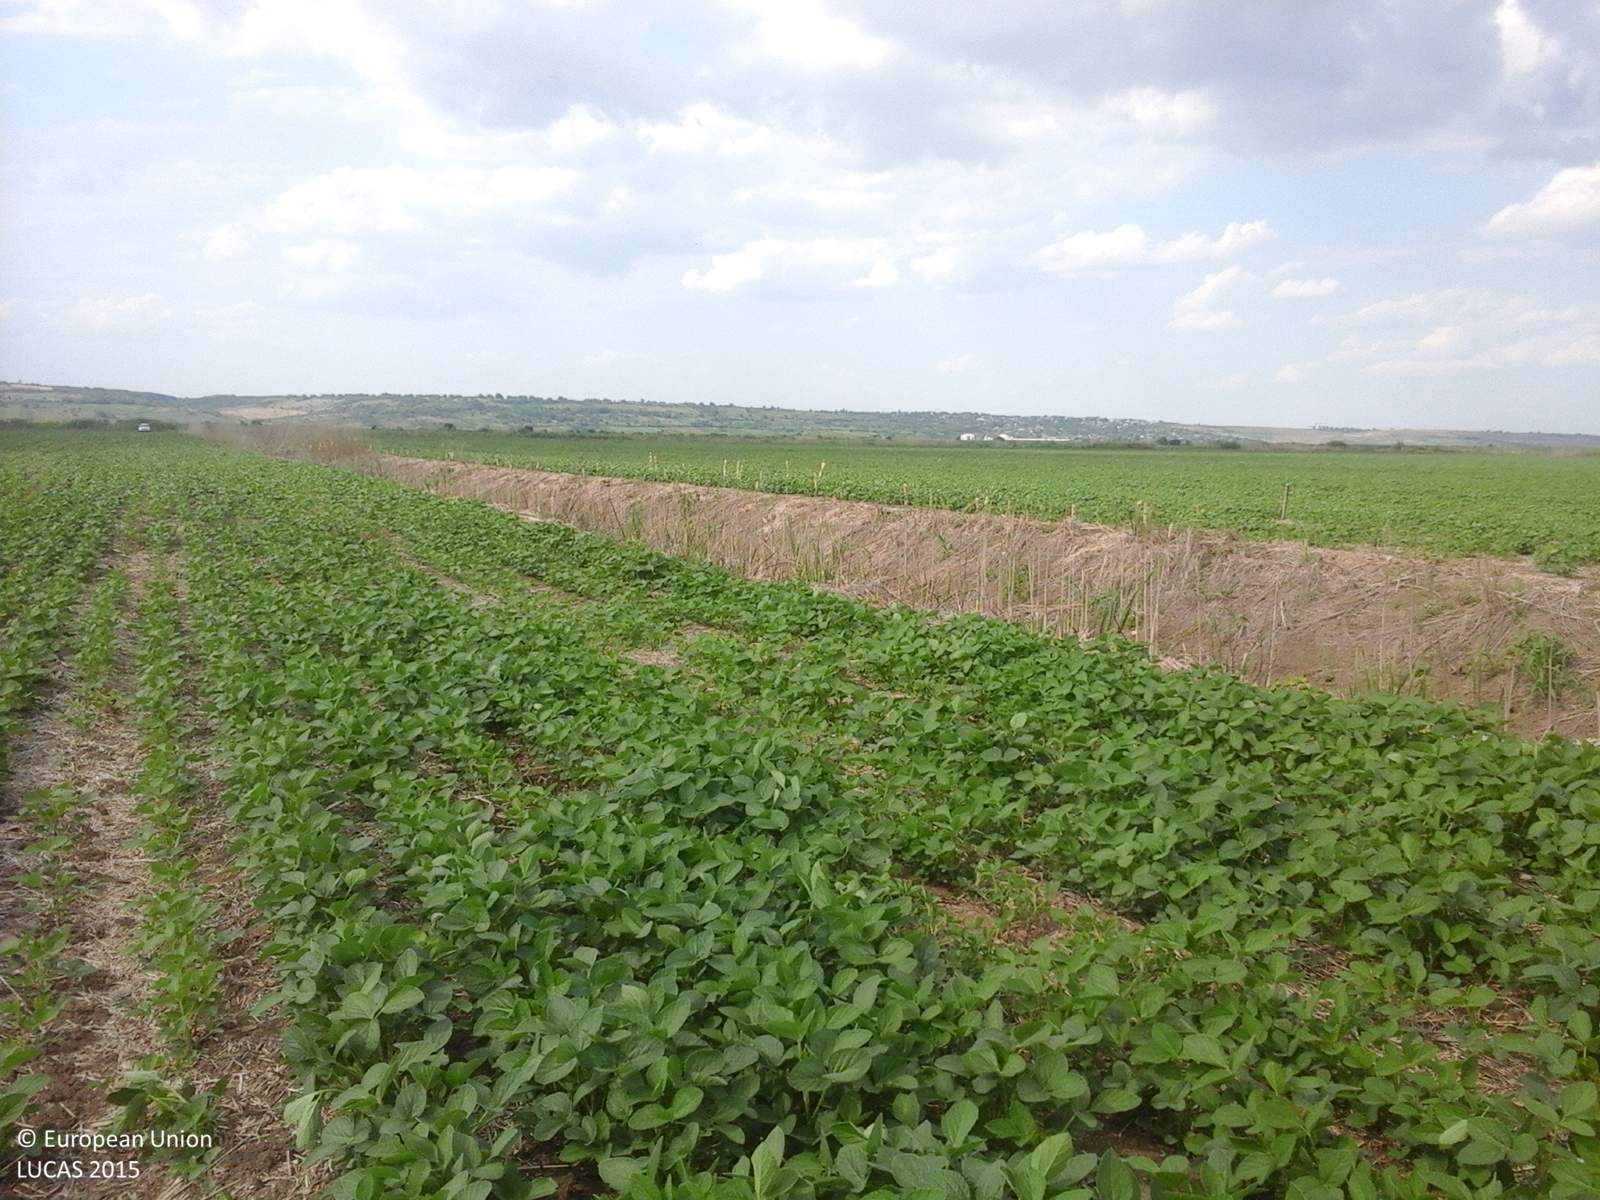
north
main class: Cropland
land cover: Soya
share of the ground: > 75 %
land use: Agriculture (excluding fallow land and kitchen gardens)
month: June
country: RO
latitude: 44.0562
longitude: 26.2191
